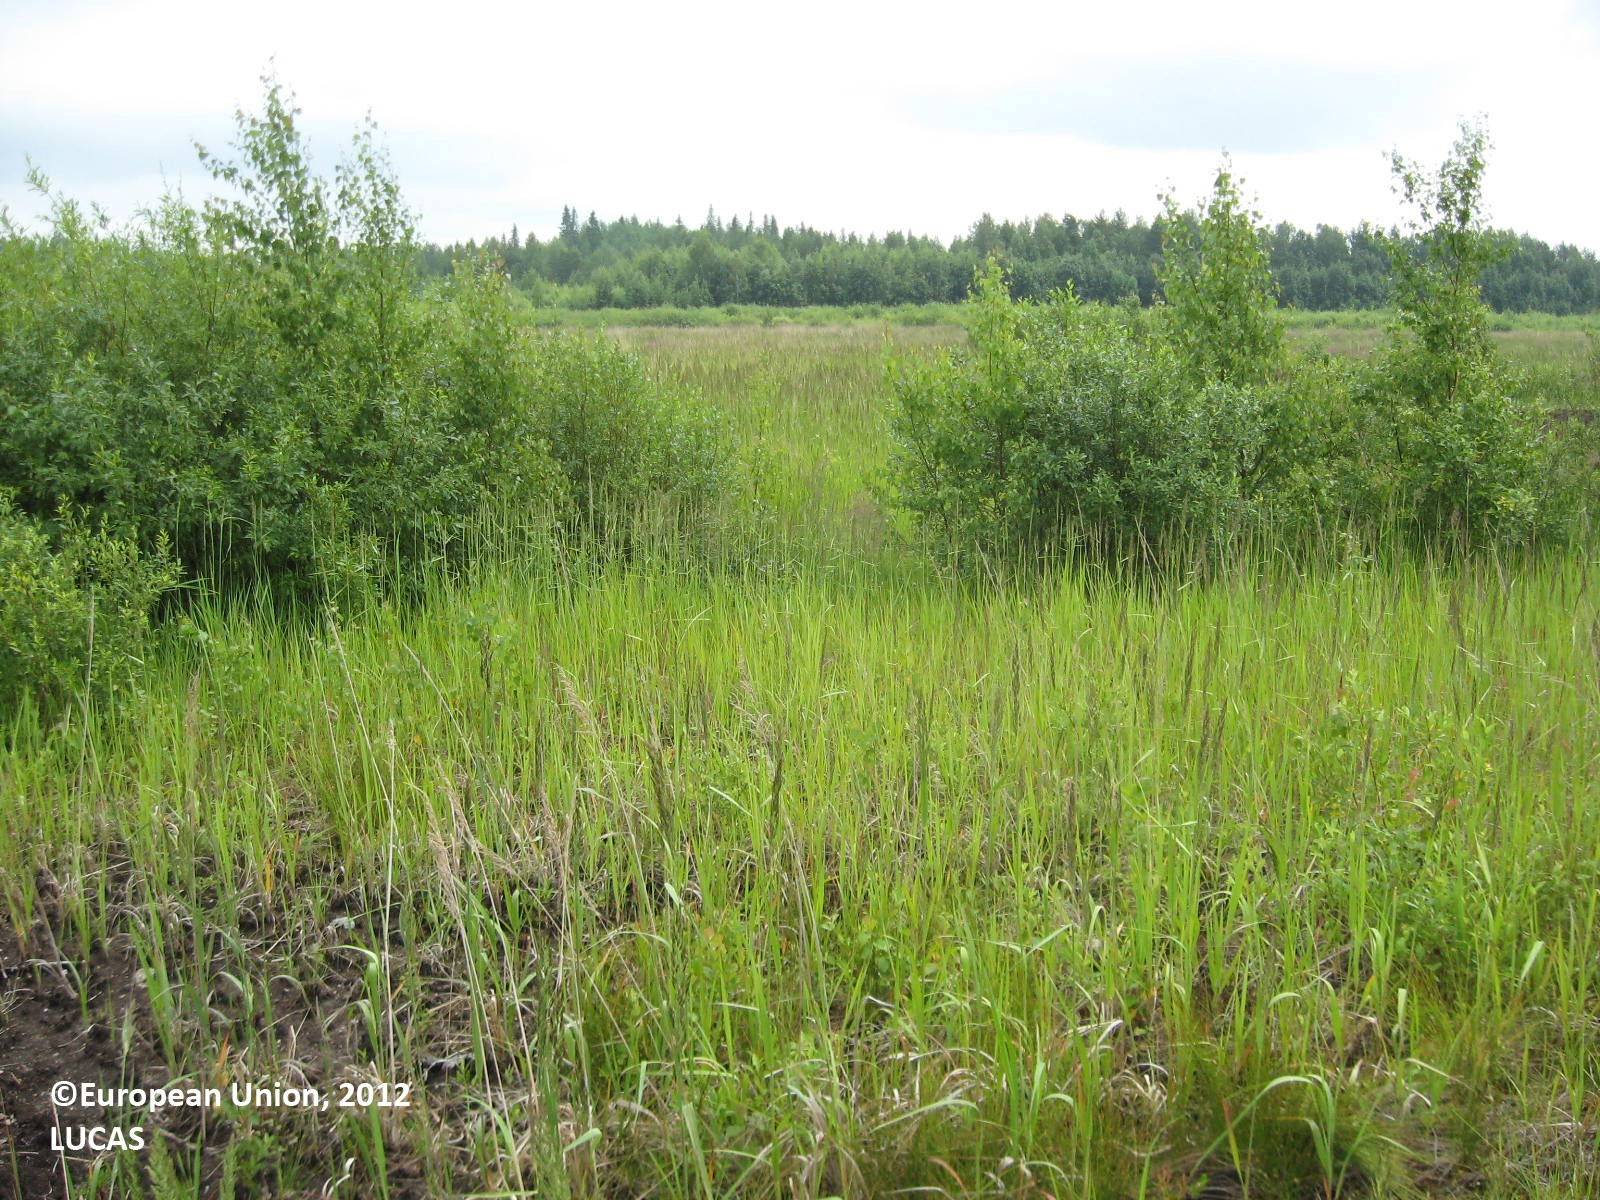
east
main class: Grassland
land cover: Spontaneously vegetated surfaces
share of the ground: > 75 %
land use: Abandoned areas
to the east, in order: Spontaneously vegetated surfaces; Ditches and canals; Spontaneously vegetated surfaces; Ditches and canals; Spontaneously vegetated surfaces; Ditches and canals; Spontaneously vegetated surfaces; Ditches and canals; Spontaneously vegetated surfaces; Ditches and canals; Spontaneously vegetated surfaces; Ditches and canals; Spontaneously vegetated surfaces; Ditches and canals; Spontaneously vegetated surfaces; Ditches and canals; Spontaneously vegetated surfaces; Ditches and canals; Spontaneously vegetated surfaces; Other mixed woodland
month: July
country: FI
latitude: 62.4679
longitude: 22.5646
